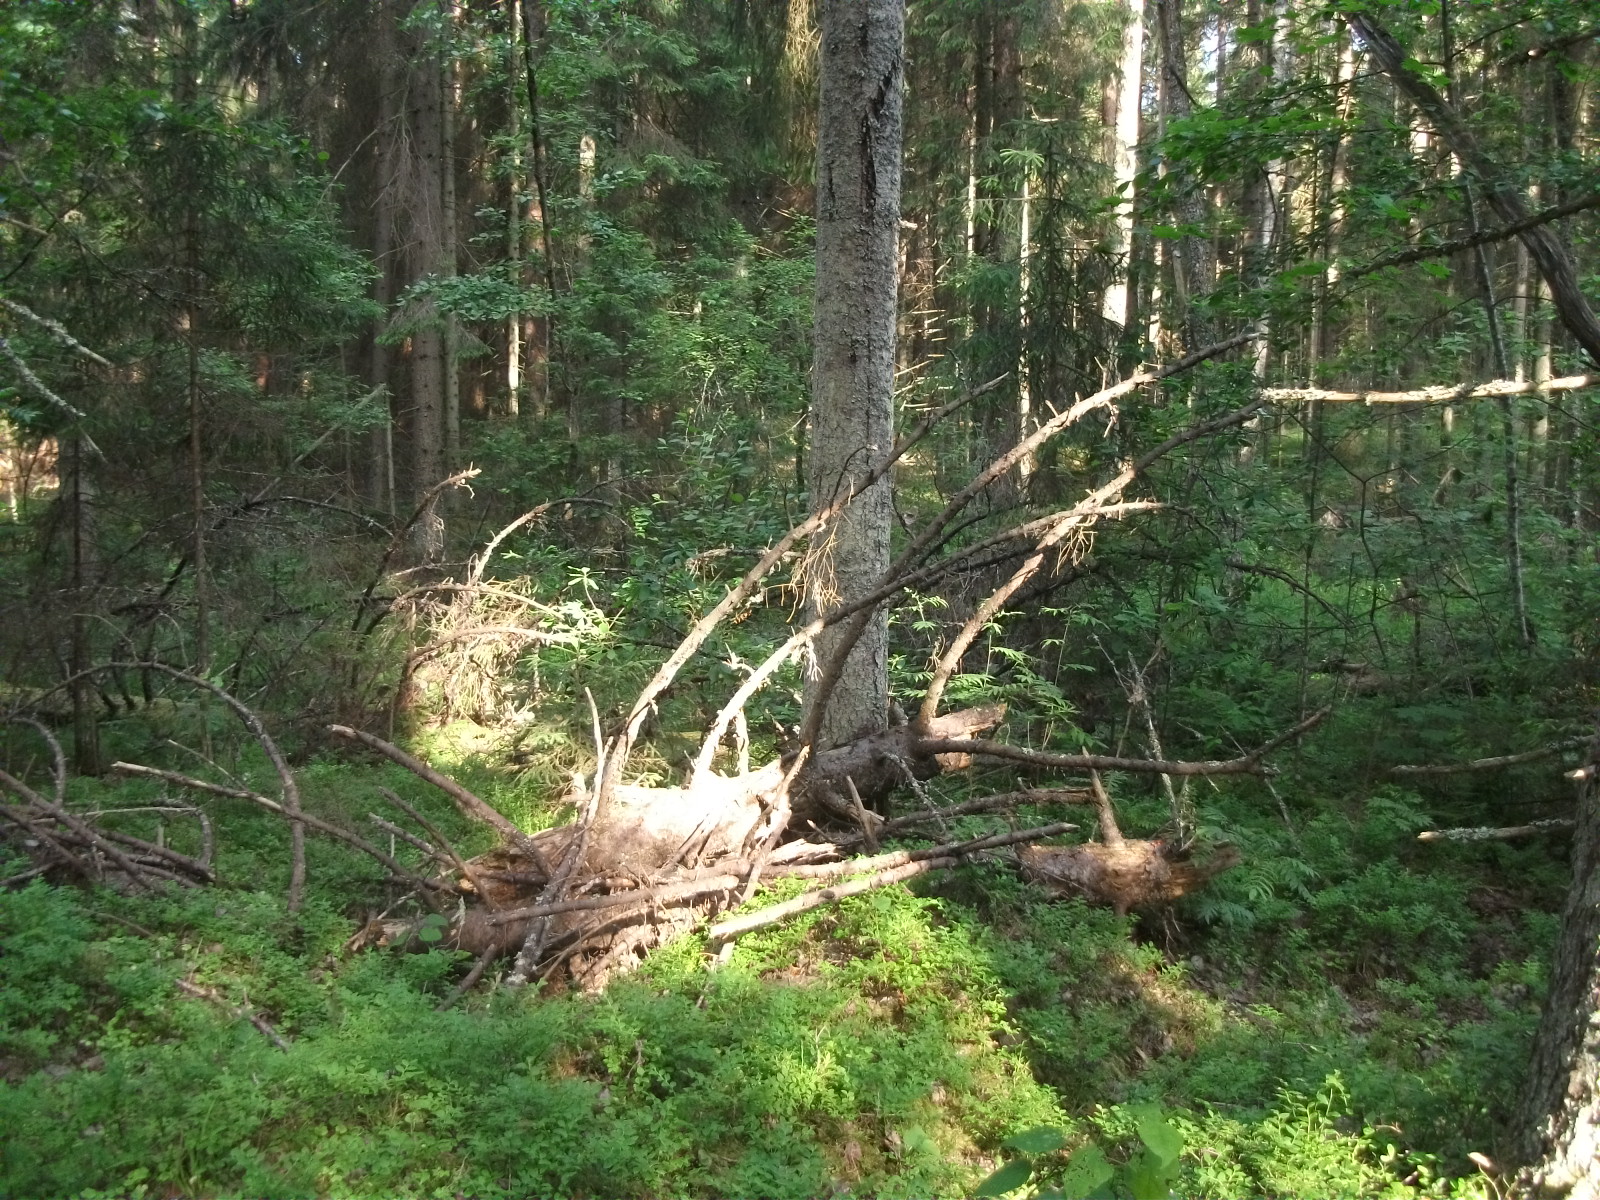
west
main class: Woodland
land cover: Other coniferous woodland
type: hemiboreal forest and nemoral coniferous forest and mixed broadleaved-coniferous forest
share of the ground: > 75 %
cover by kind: coniferous forest trees 85 %, shrubs 10 %, lichens and mosses 5 %
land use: Forestry
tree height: > 5 m
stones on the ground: < 10 %
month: July
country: LV
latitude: 57.1516
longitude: 26.3562
